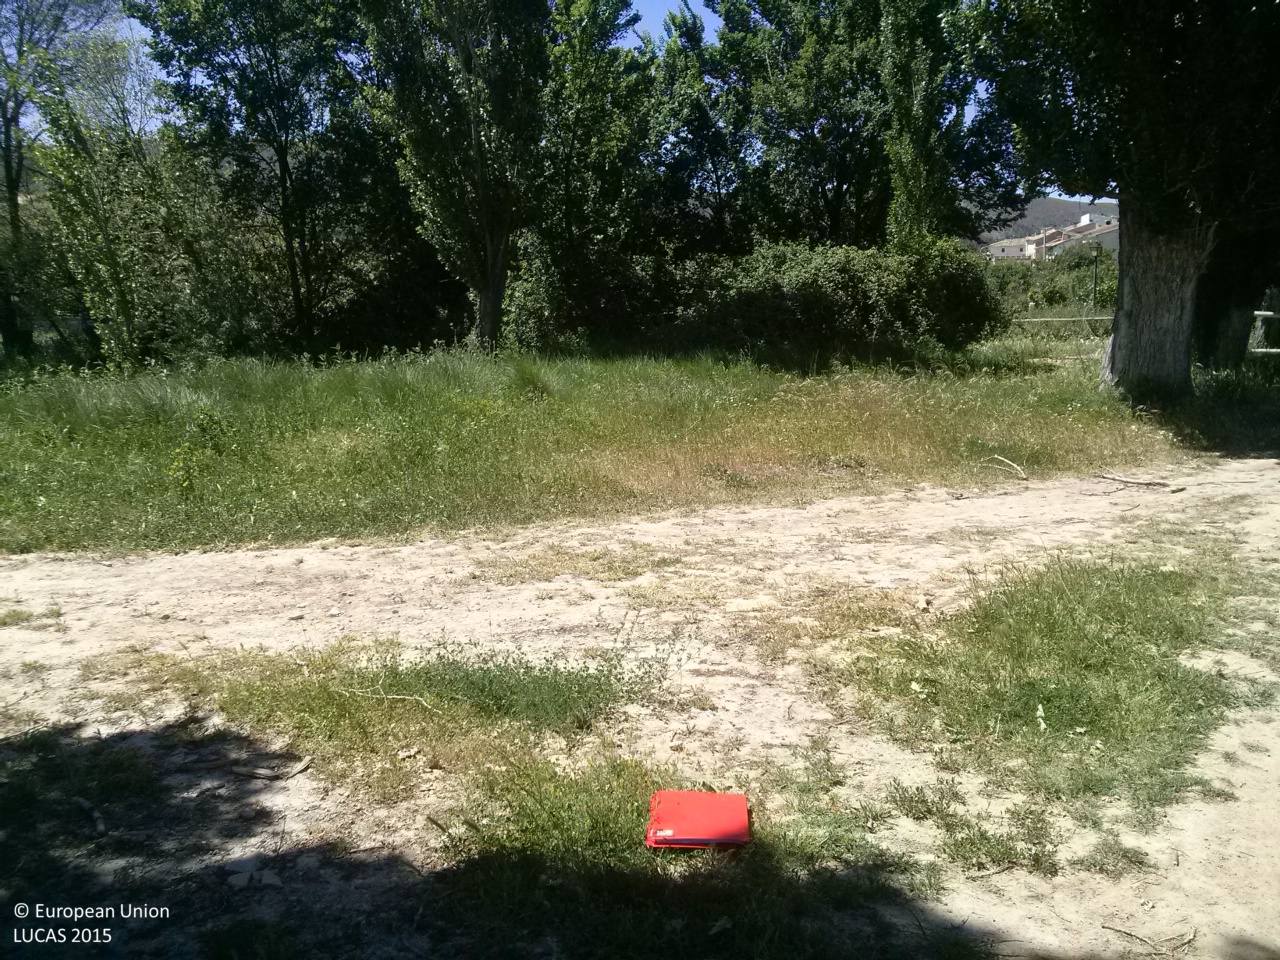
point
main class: Grassland
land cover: Grassland with sparse tree/shrub cover
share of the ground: 50 - 75 %
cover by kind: herbaceous plants 60 %, unconsolidated bare surface 35 %, broadleaved forest trees 5 %
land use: Abandoned areas
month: May
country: ES
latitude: 40.3639
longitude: -2.7553
